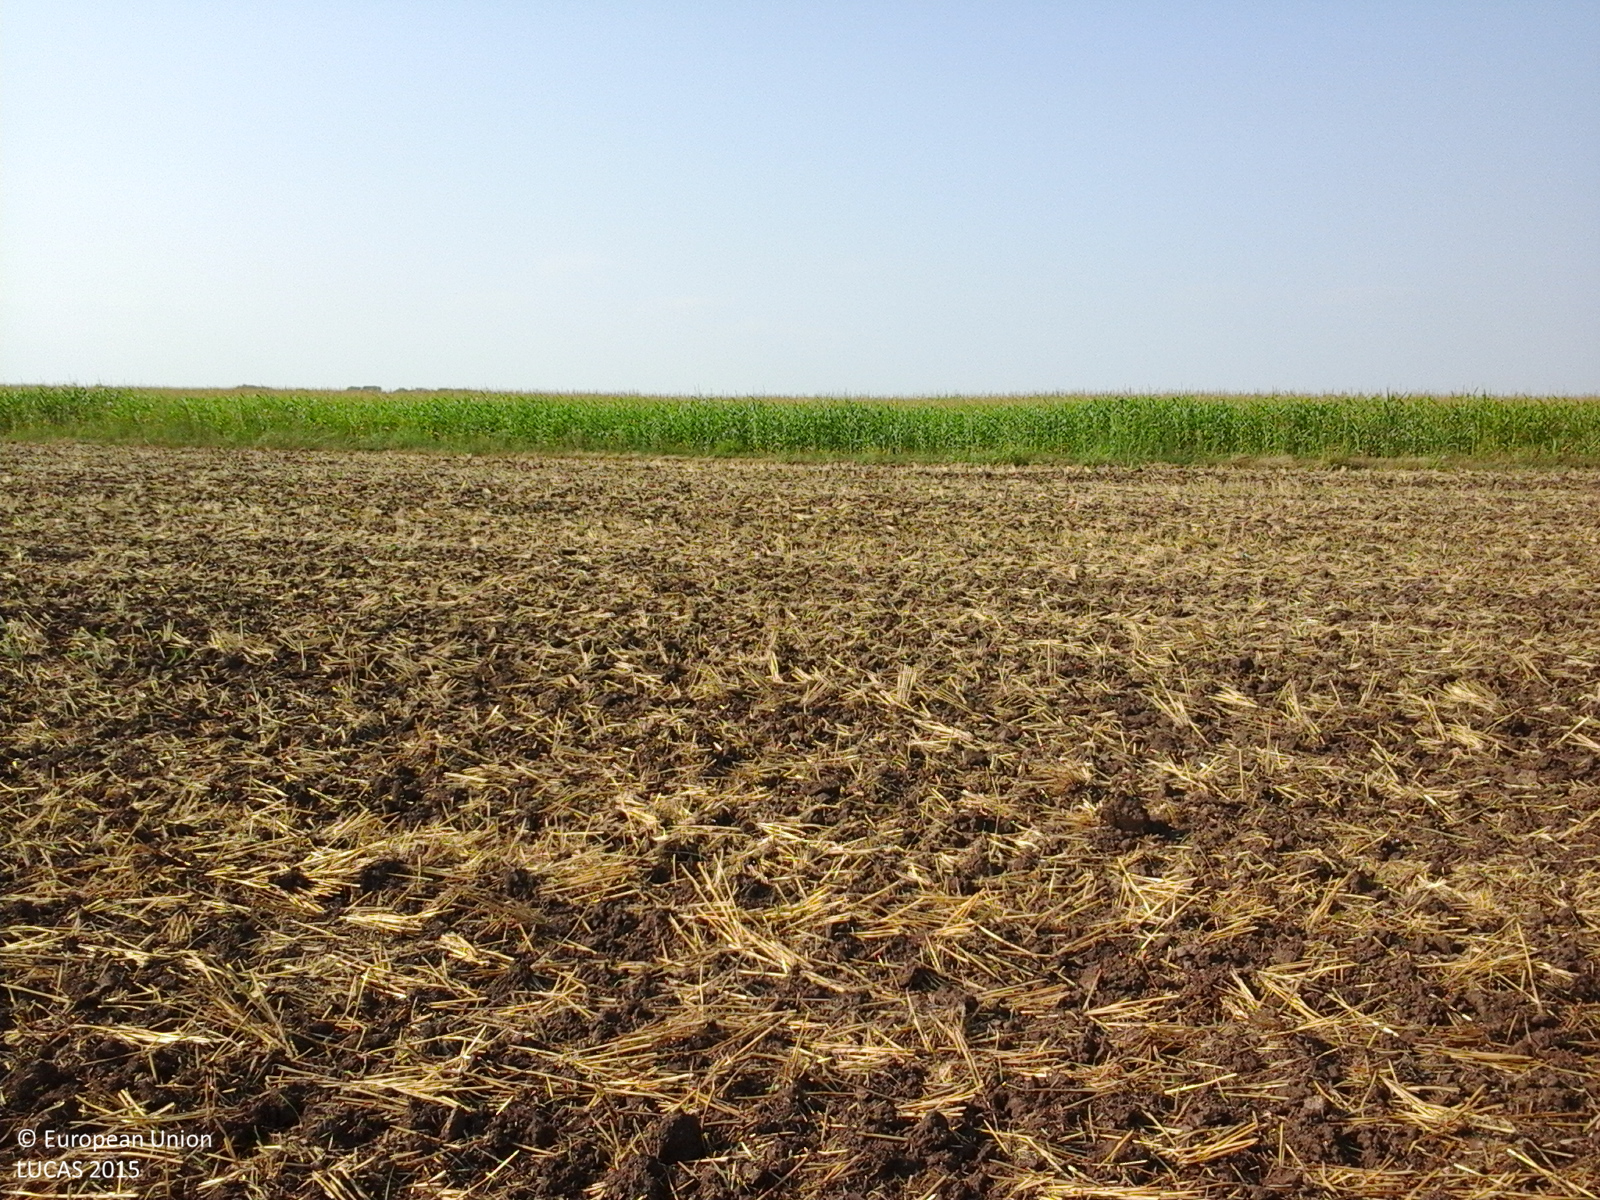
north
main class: Cropland
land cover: Common wheat
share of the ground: < 10 %
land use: Agriculture (excluding fallow land and kitchen gardens)
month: July
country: RO
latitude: 44.8593
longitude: 27.1580
